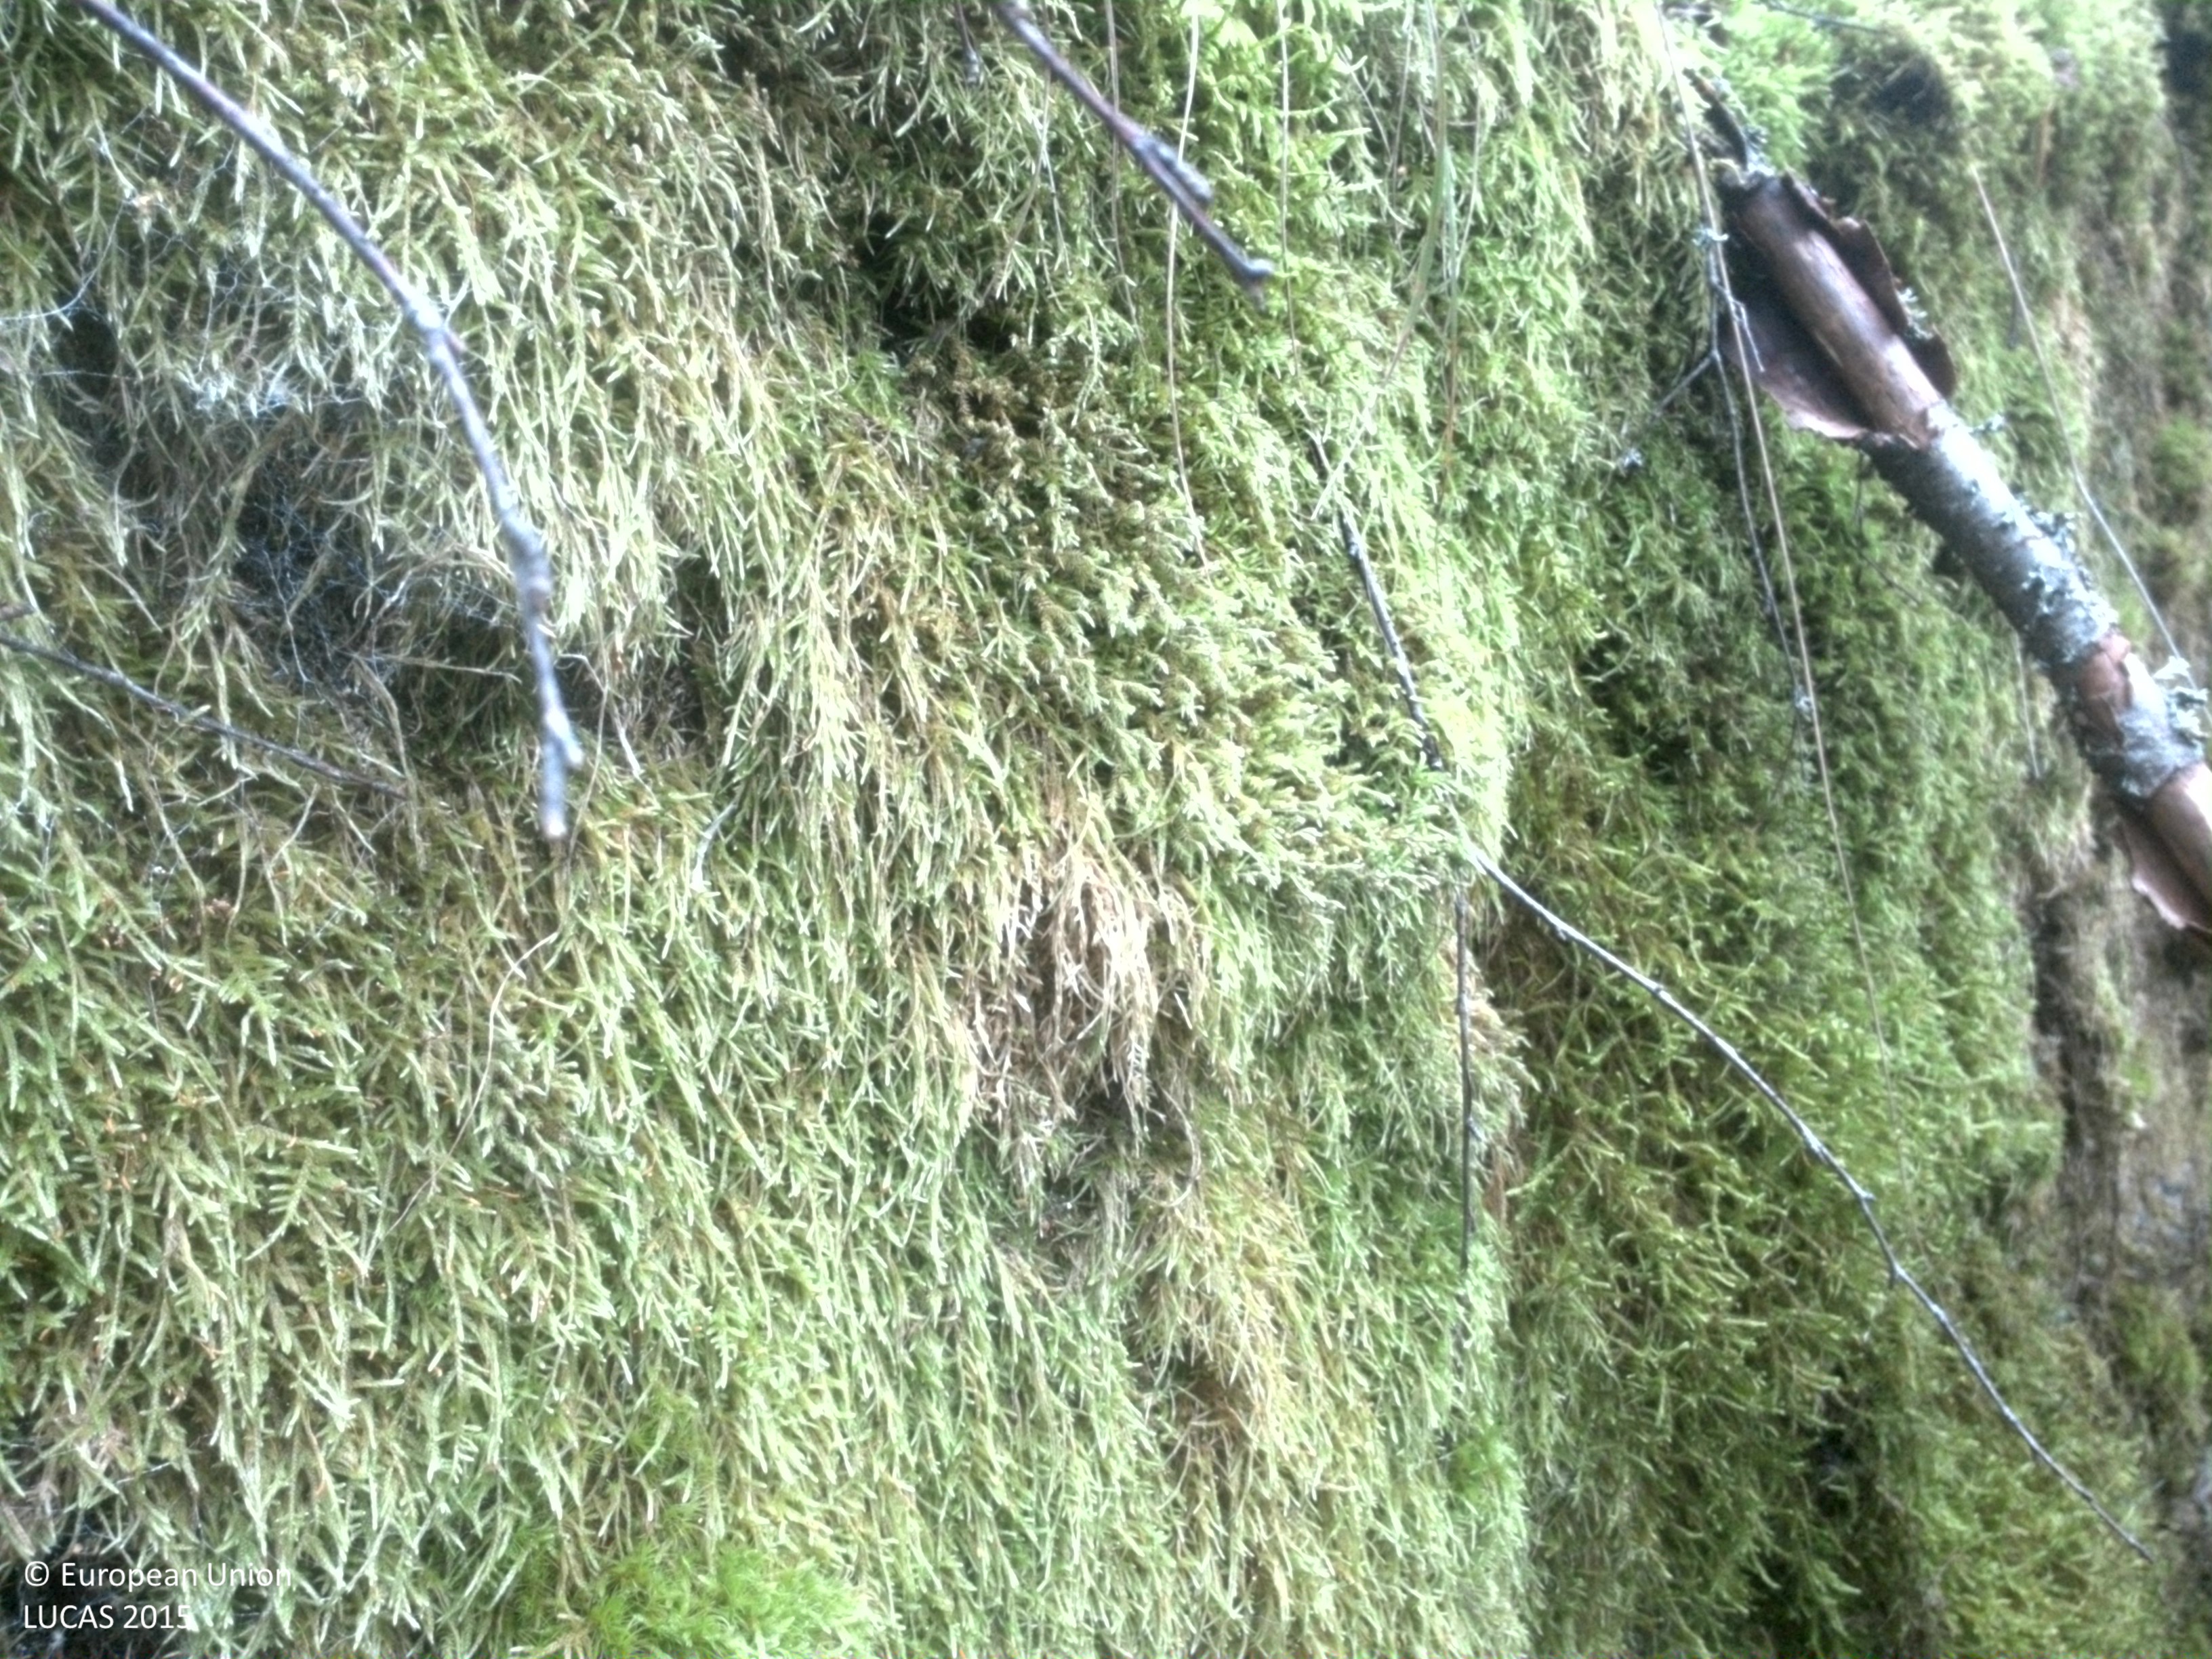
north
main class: Woodland
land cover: Spruce dominated mixed woodland
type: boreal forest
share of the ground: 50 - 75 %
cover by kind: coniferous forest trees 40 %, broadleaved forest trees 30 %, lichens and mosses 15 %, herbaceous plants 10 %, shrubs 5 %
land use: Forestry
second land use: Amenities, museums, leisure
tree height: > 5 m
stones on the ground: 25 - 50 %
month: September
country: SE
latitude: 59.5806
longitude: 15.6393
